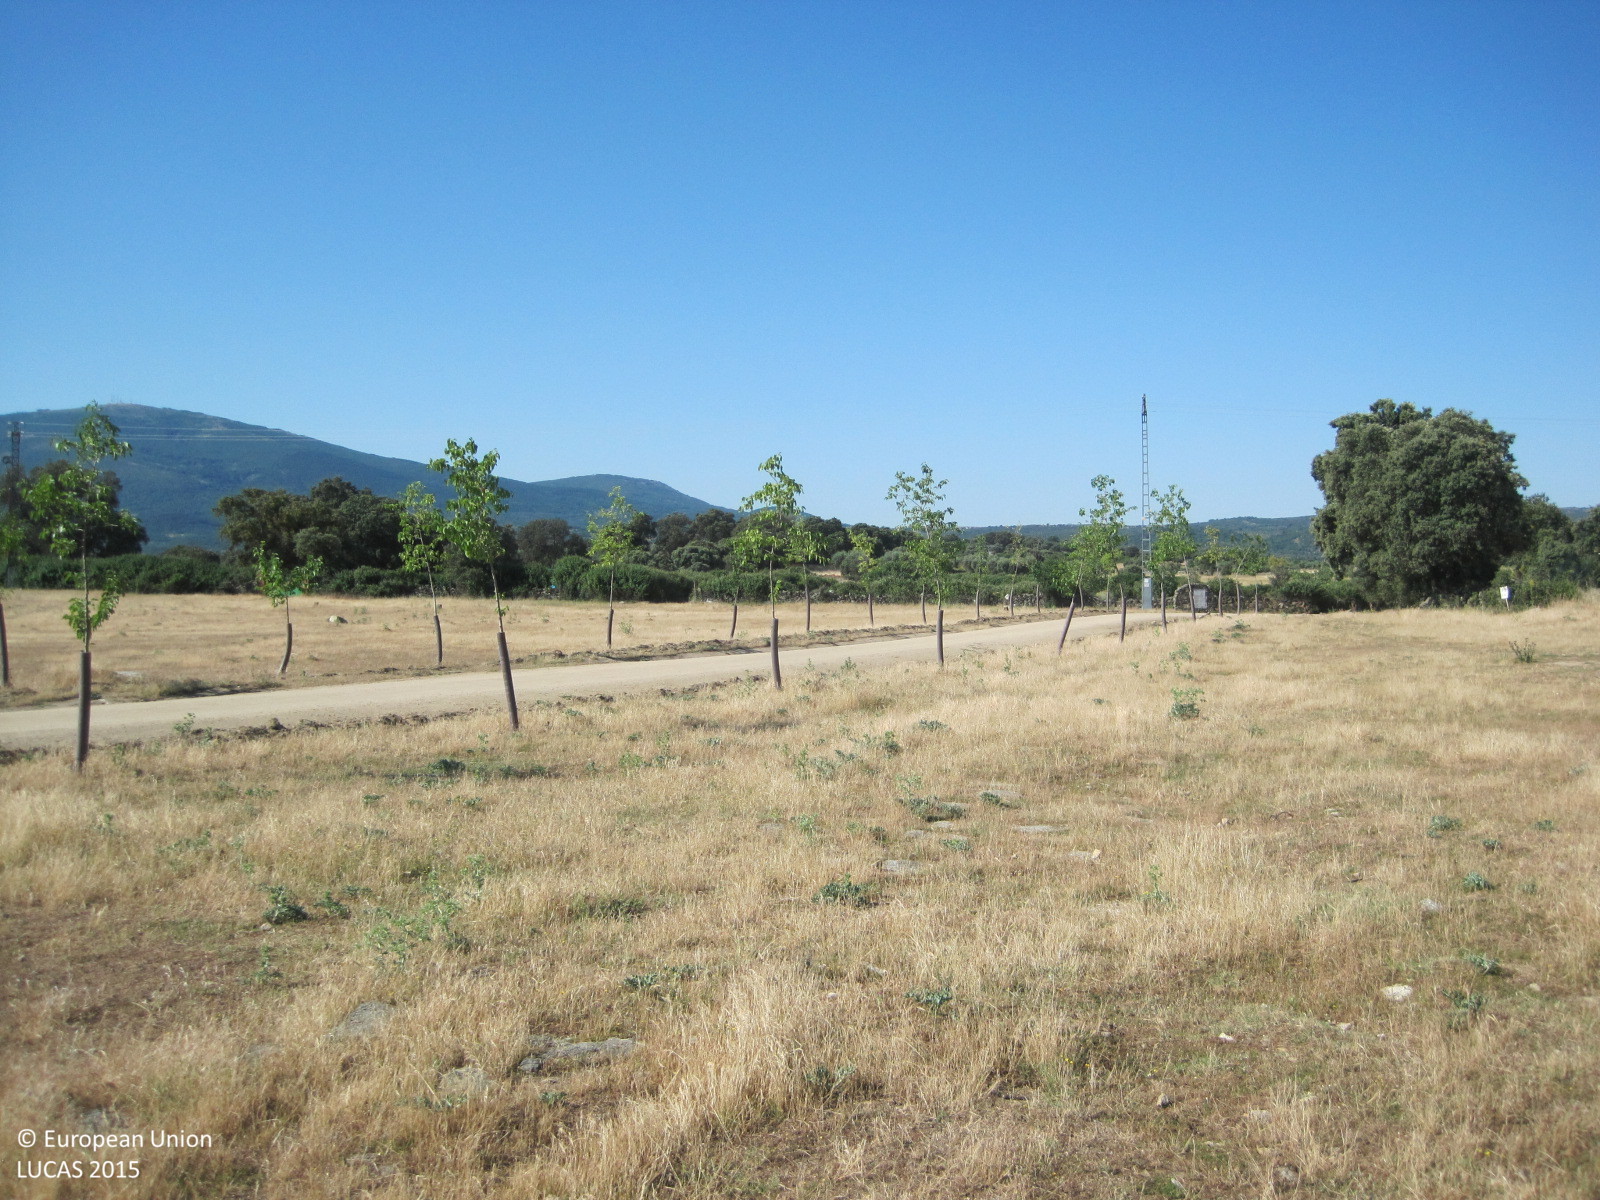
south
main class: Grassland
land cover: Grassland without tree/shrub cover
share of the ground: > 75 %
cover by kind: herbaceous plants 100 %
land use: Agriculture (excluding fallow land and kitchen gardens)
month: May
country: ES
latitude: 40.2281
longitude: -4.7527
